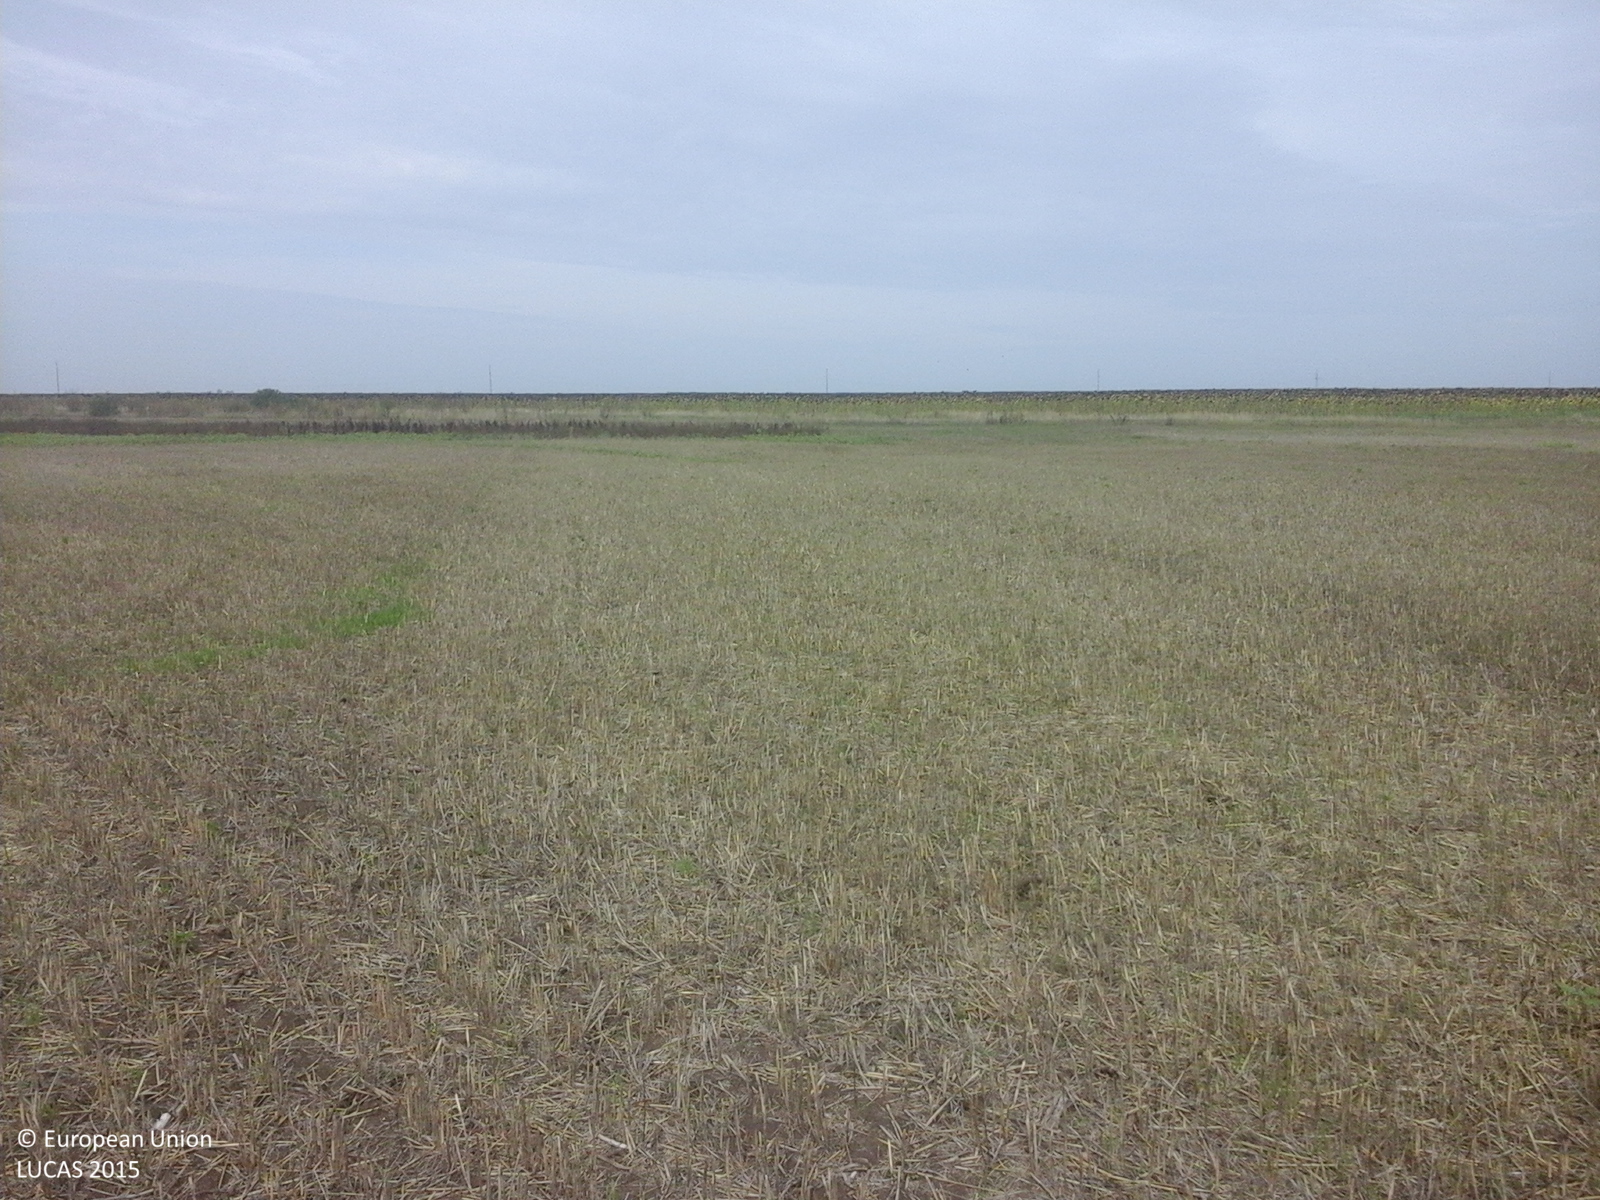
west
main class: Cropland
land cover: Common wheat
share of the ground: 50 - 75 %
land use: Agriculture (excluding fallow land and kitchen gardens)
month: August
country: RO
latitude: 46.4102
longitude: 21.4191
